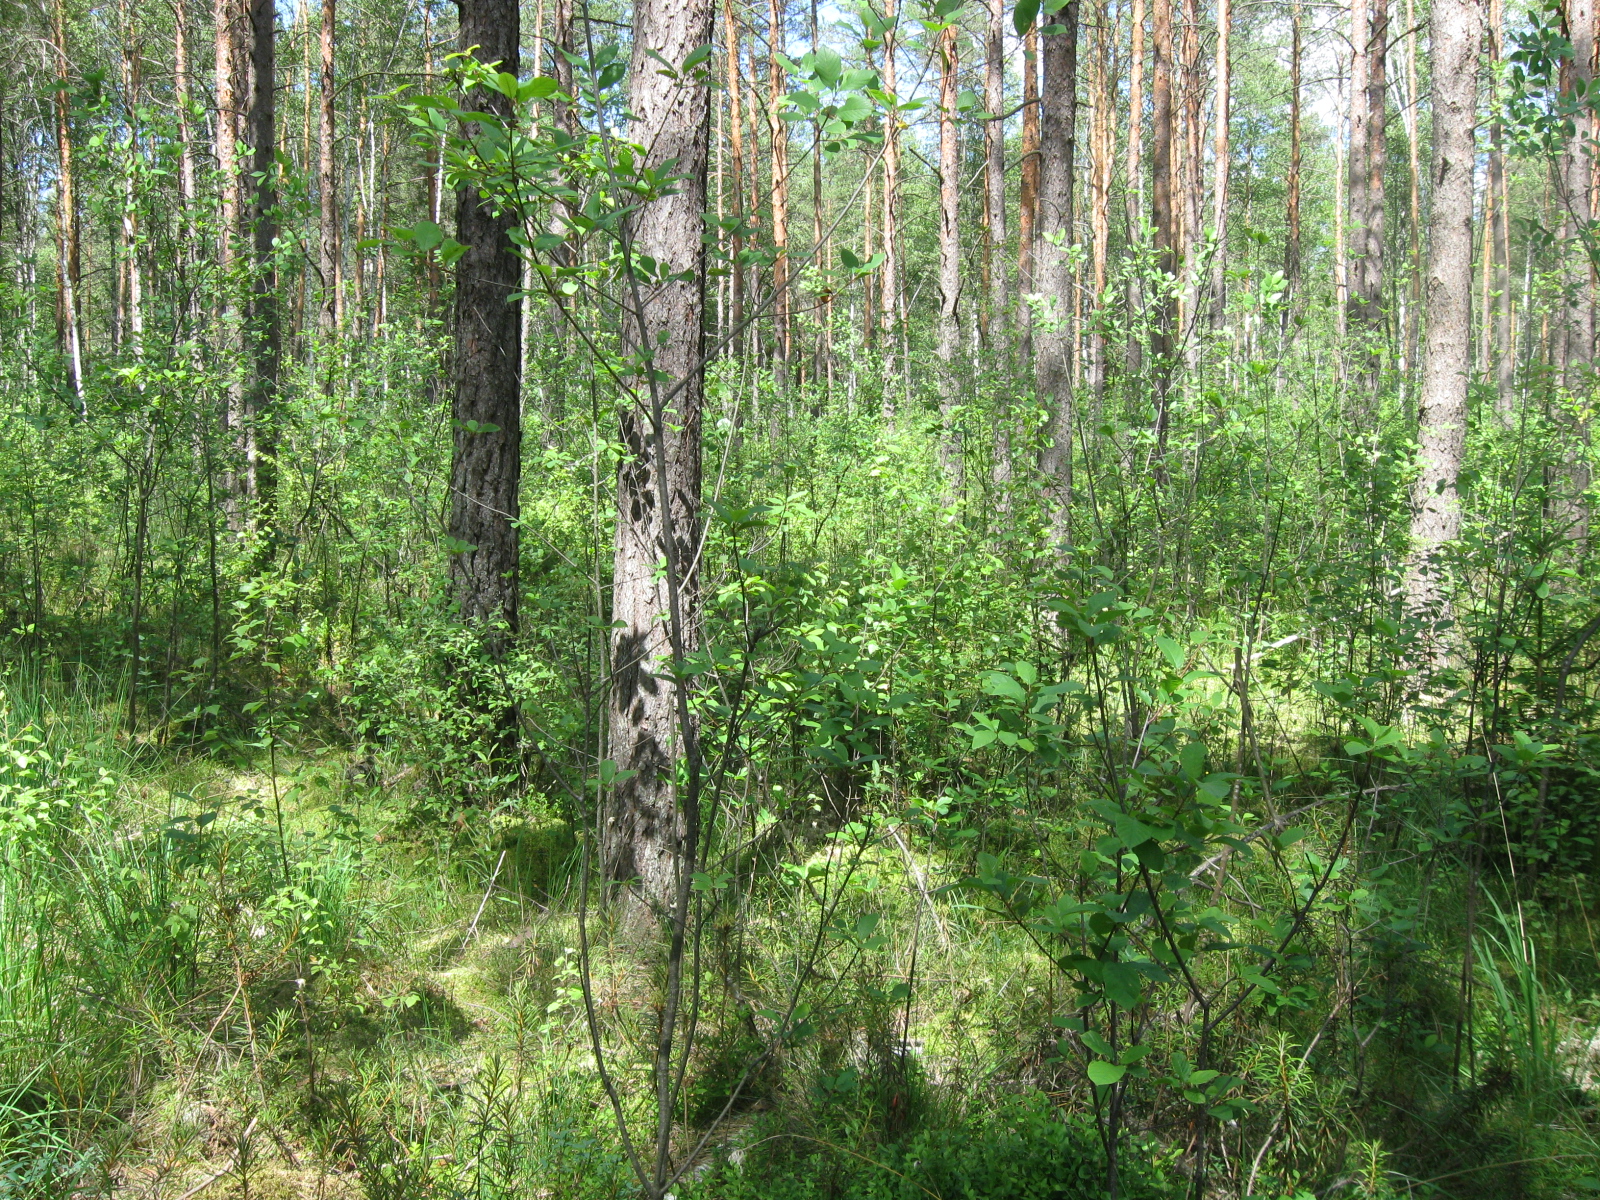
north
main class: Woodland
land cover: Pine dominated mixed woodland
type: mire and swamp forests
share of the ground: > 75 %
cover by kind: coniferous forest trees 55 %, broadleaved forest trees 30 %, herbaceous plants 15 %
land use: Forestry
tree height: > 5 m
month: June
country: LT
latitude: 53.9807
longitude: 24.2336
